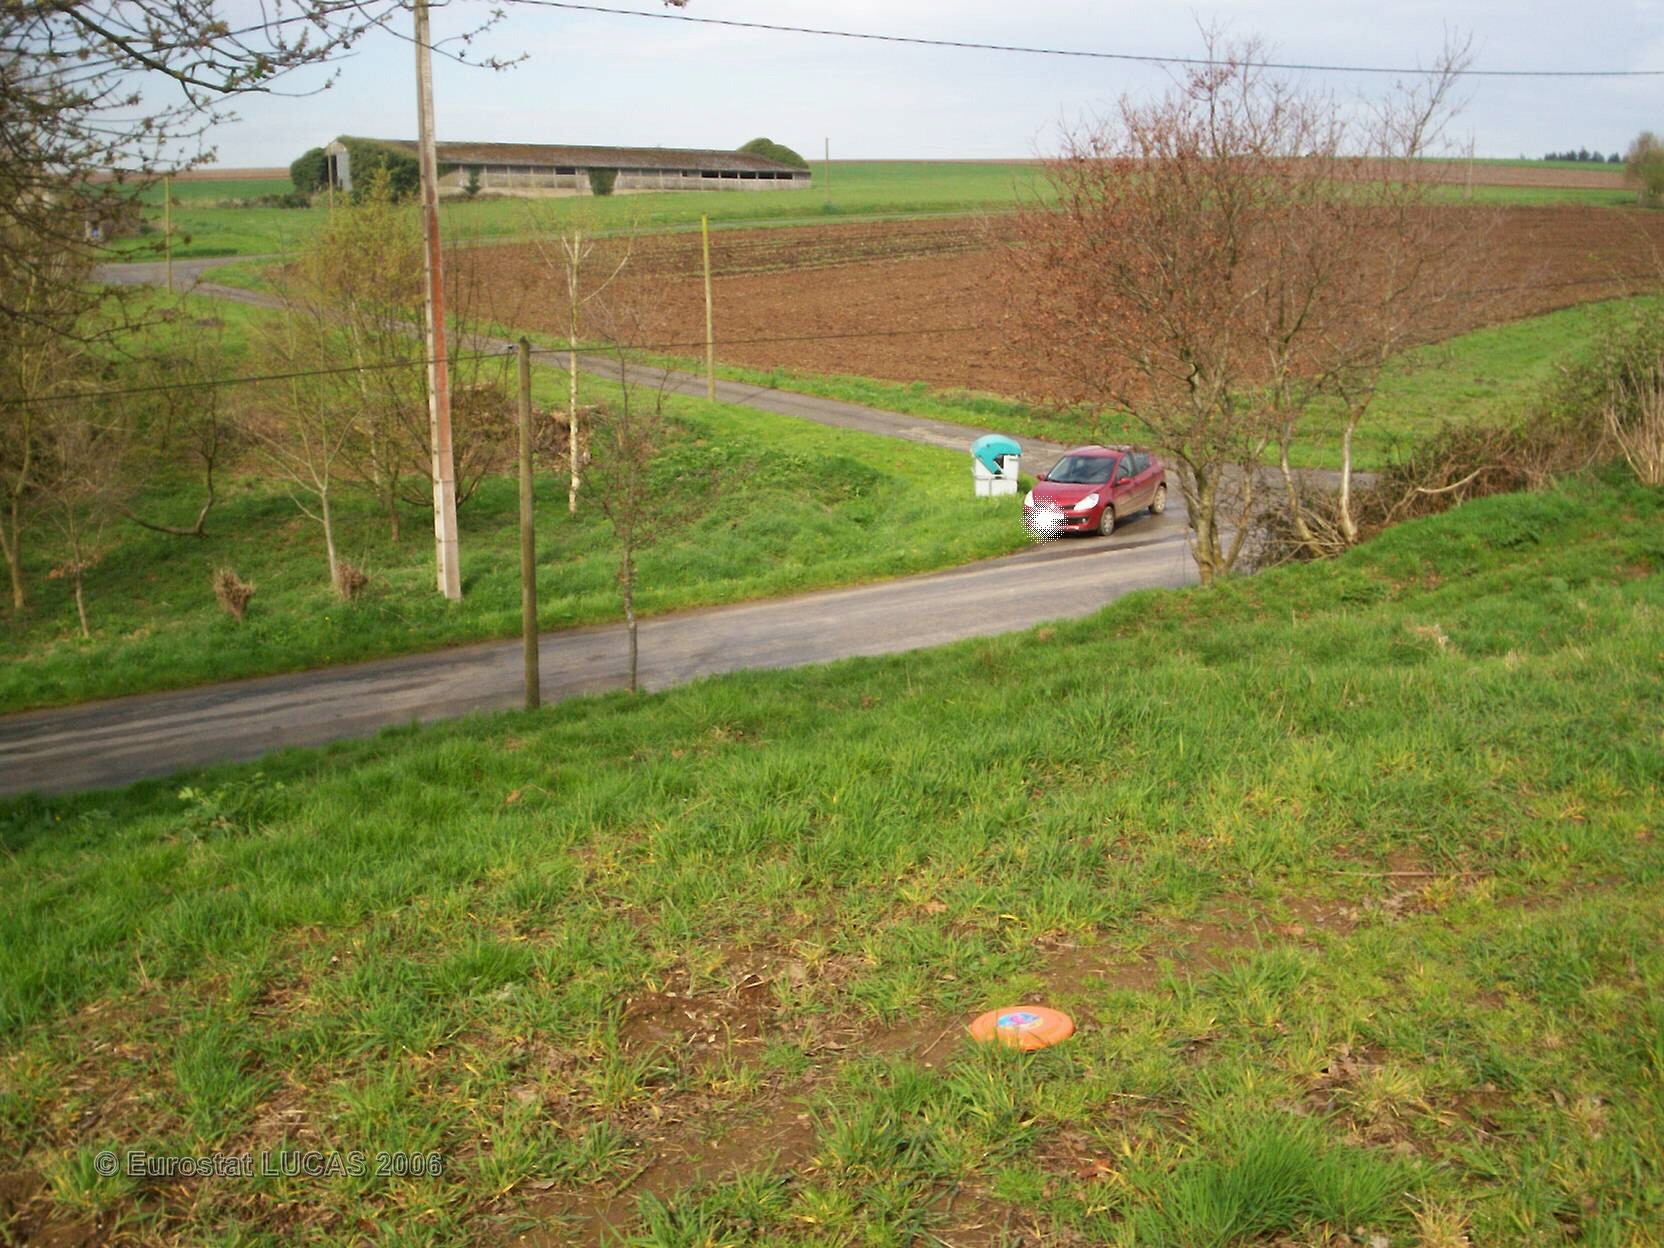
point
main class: Grassland
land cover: Grassland without tree/shrub cover
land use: Agriculture (excluding fallow land and kitchen gardens)
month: April
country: FR
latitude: 48.0475
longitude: -2.8771
